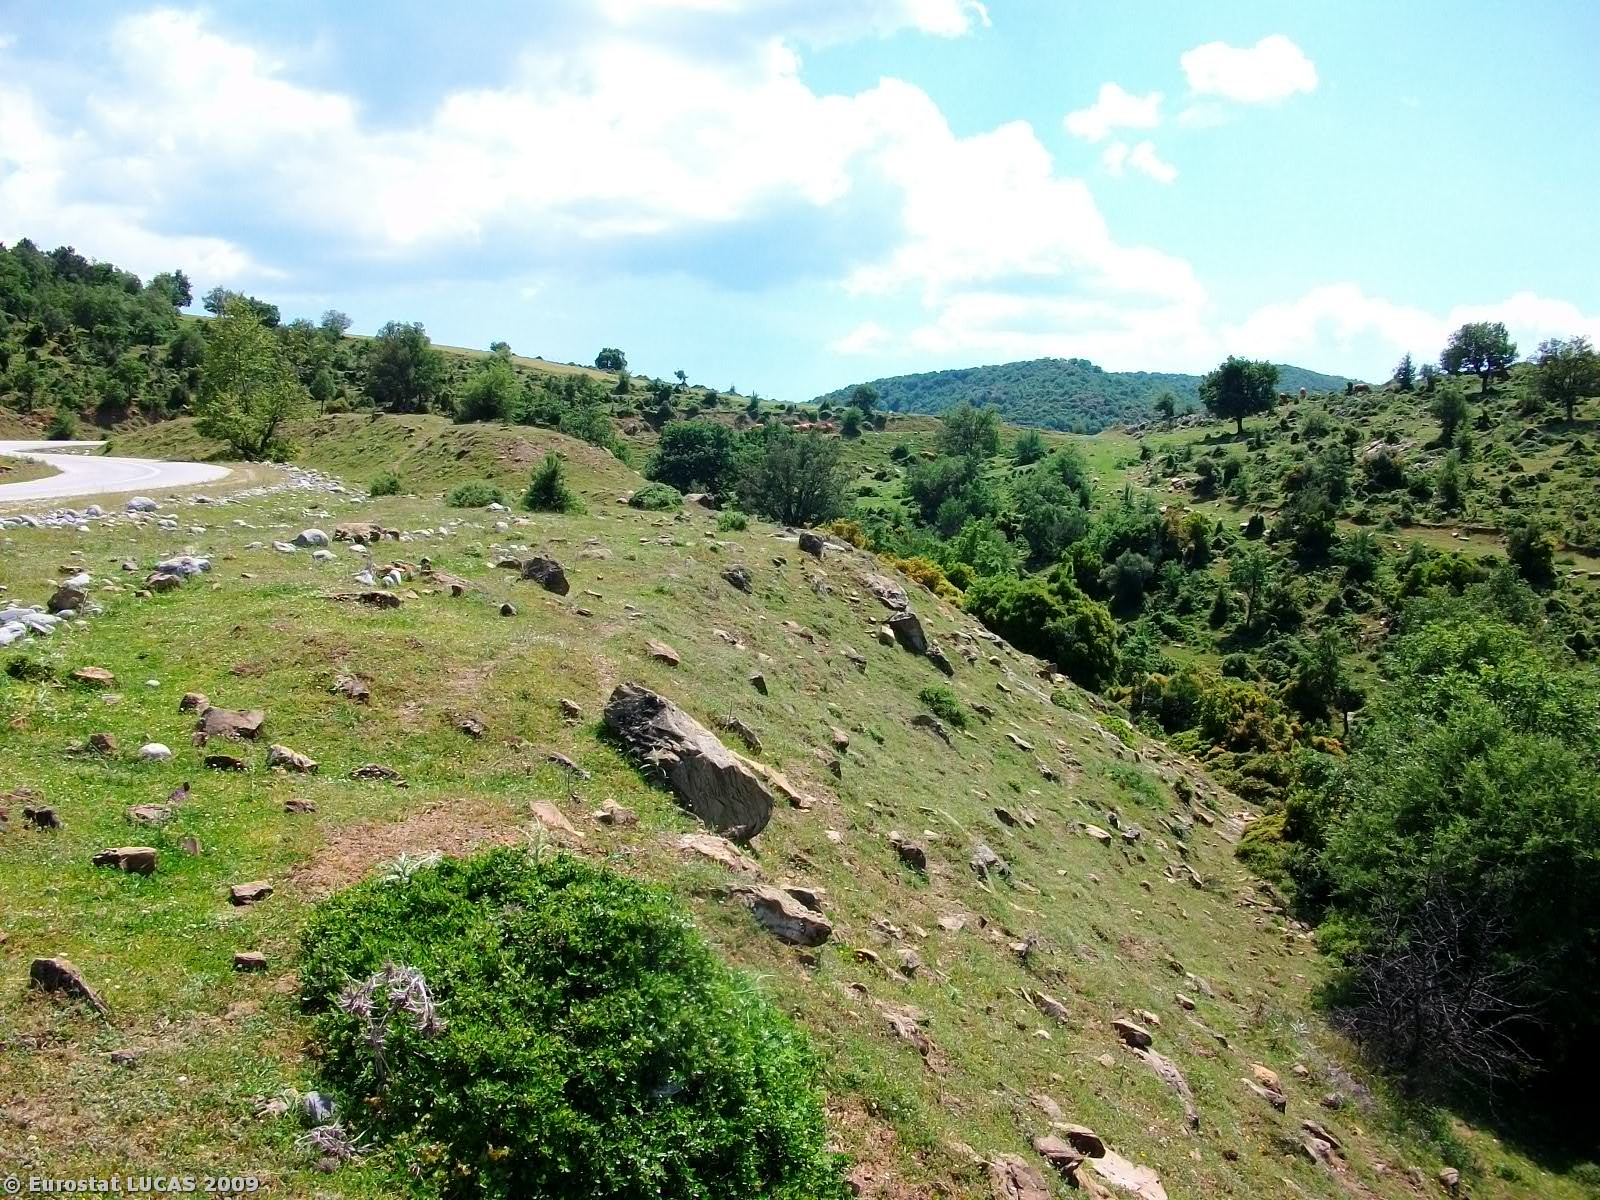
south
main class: Woodland
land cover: Broadleaved woodland
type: acidophilous oak and oak-birch forest
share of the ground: > 75 %
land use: Forestry
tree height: > 5 m
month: May
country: GR
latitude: 39.1633
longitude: 22.5654
